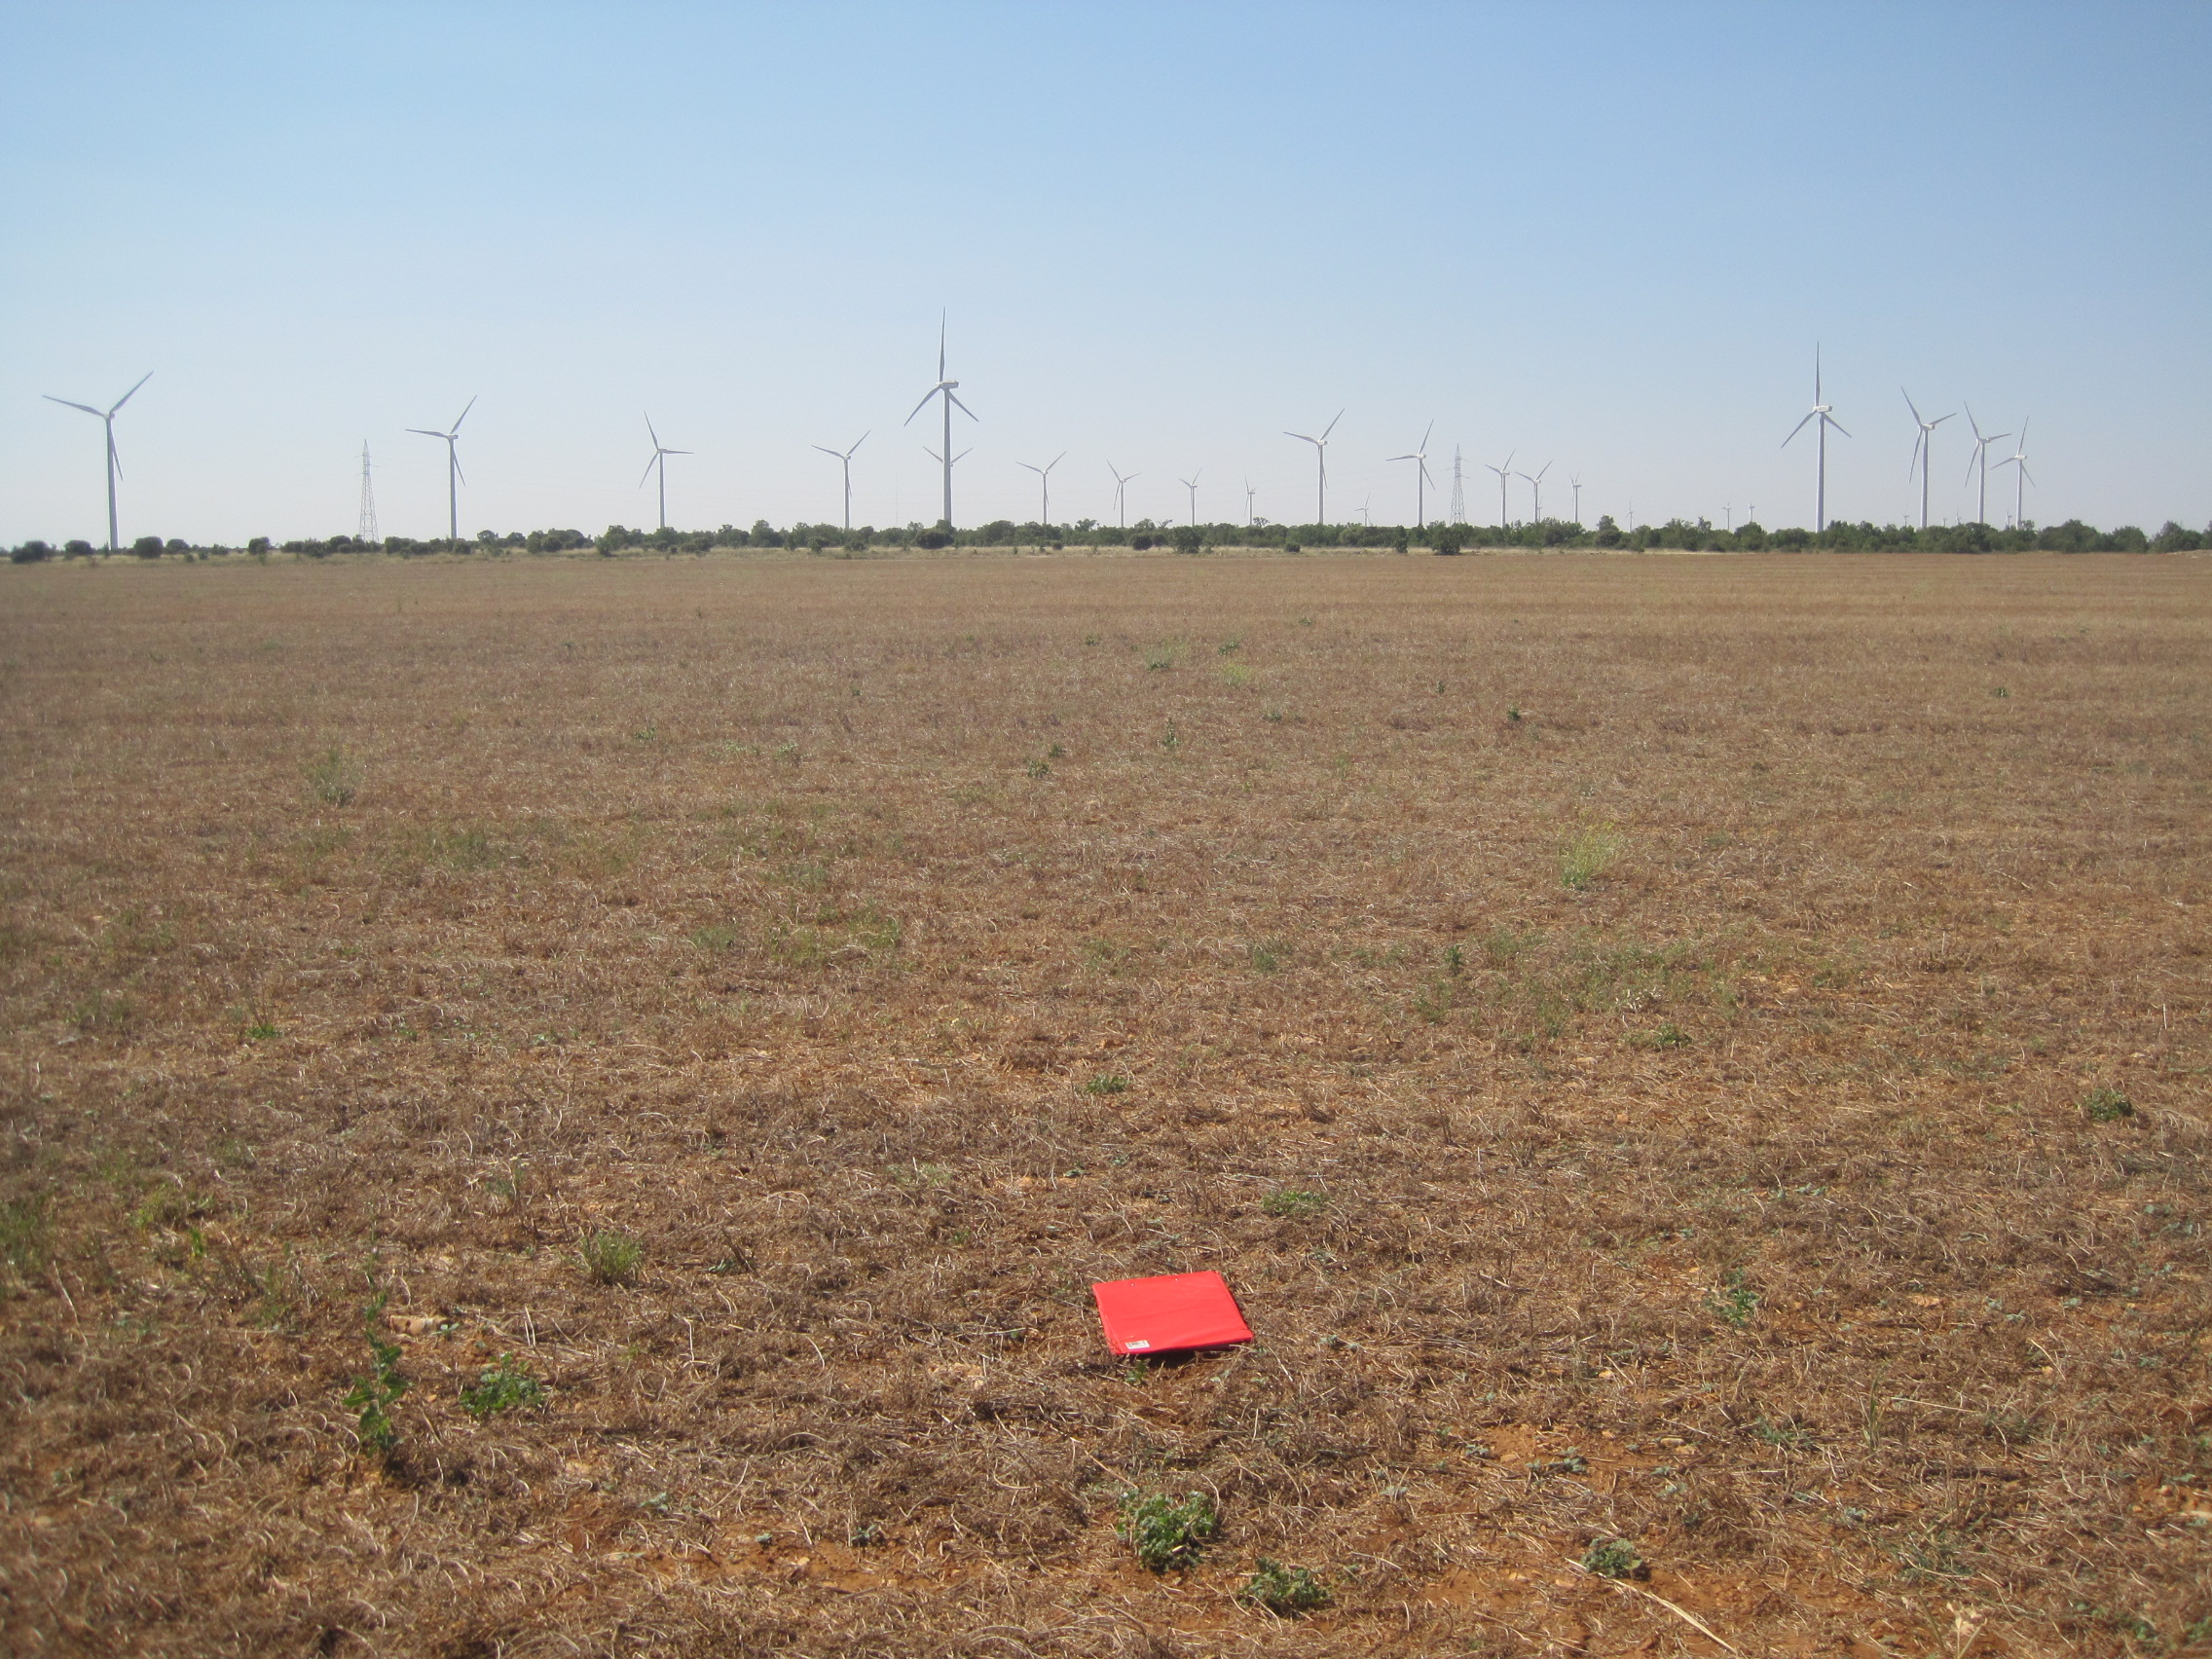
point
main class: Cropland
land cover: Dry pulses
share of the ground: < 10 %
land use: Agriculture (excluding fallow land and kitchen gardens)
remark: Harvested field
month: July
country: ES
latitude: 41.8985
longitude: -4.7418
